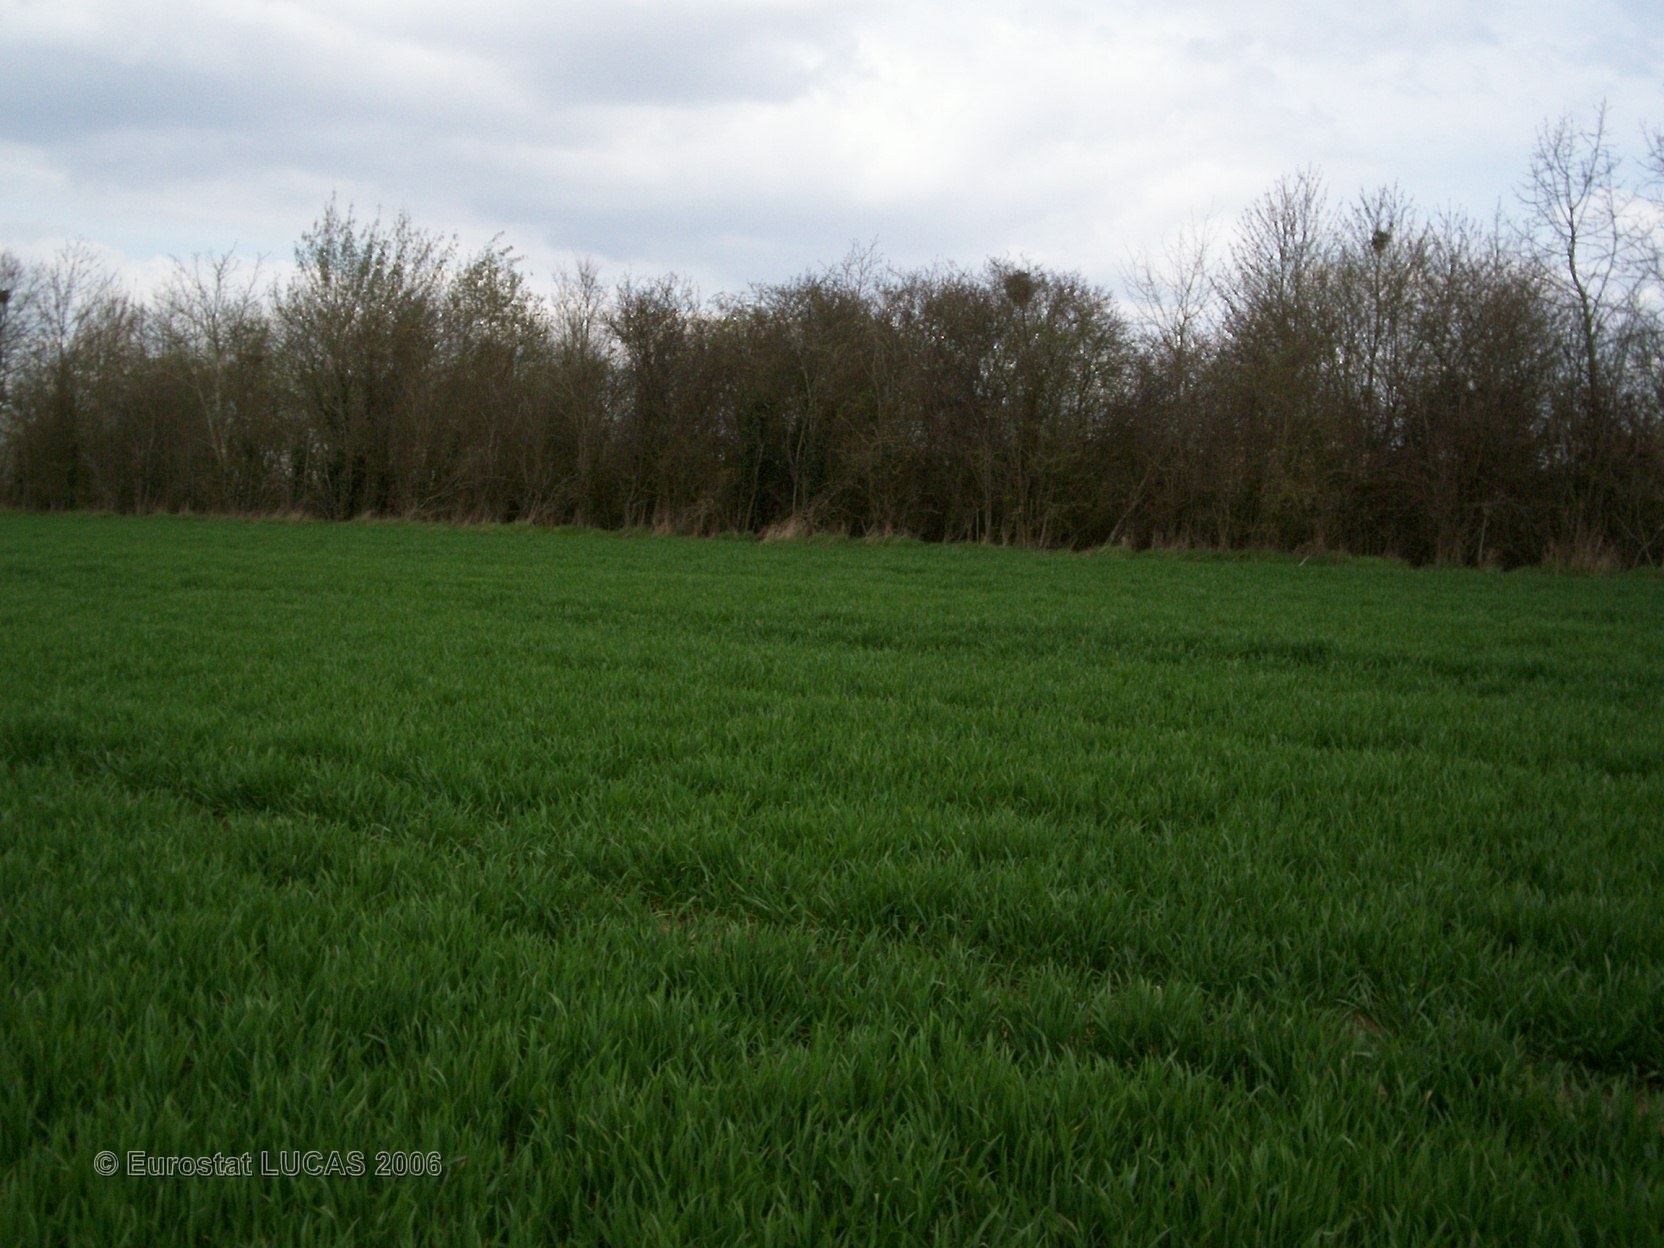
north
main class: Cropland
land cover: Common wheat
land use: Agriculture (excluding fallow land and kitchen gardens)
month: April
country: FR
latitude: 49.1043
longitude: 1.0064
